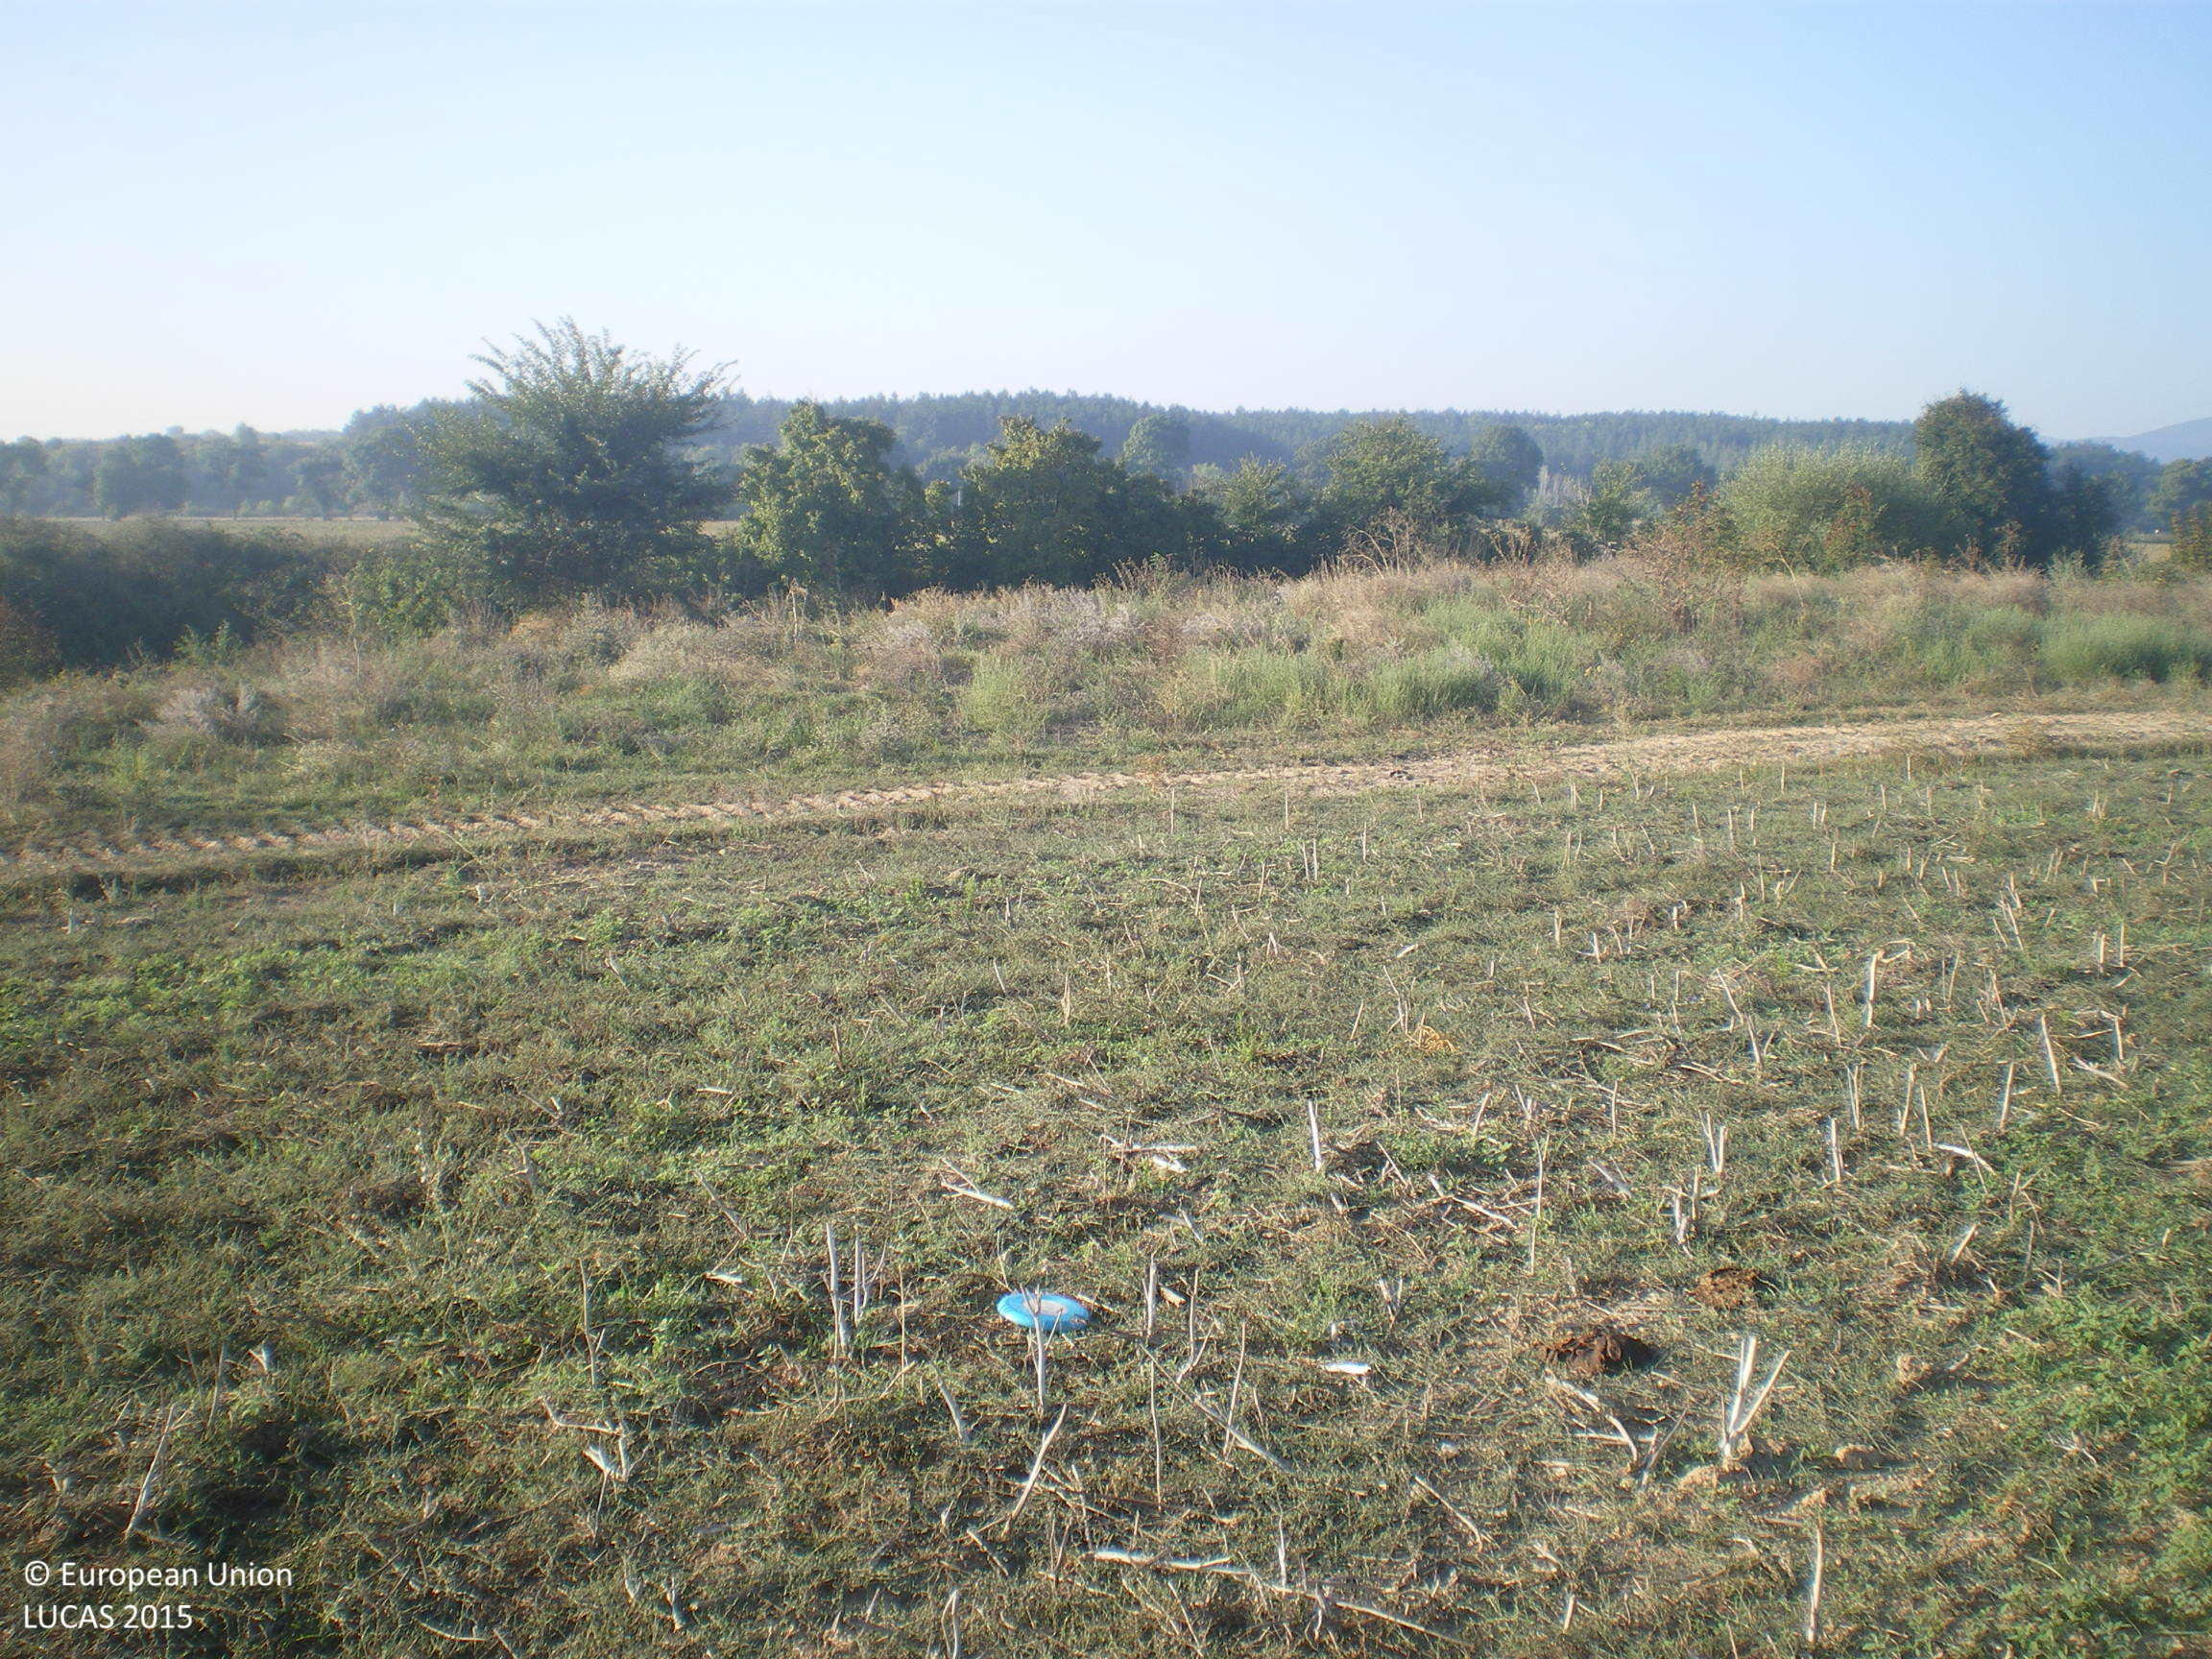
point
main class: Cropland
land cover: Rape and turnip rape
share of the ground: < 10 %
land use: Agriculture (excluding fallow land and kitchen gardens)
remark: Harvested field
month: September
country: BG
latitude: 41.7733
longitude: 26.1347
